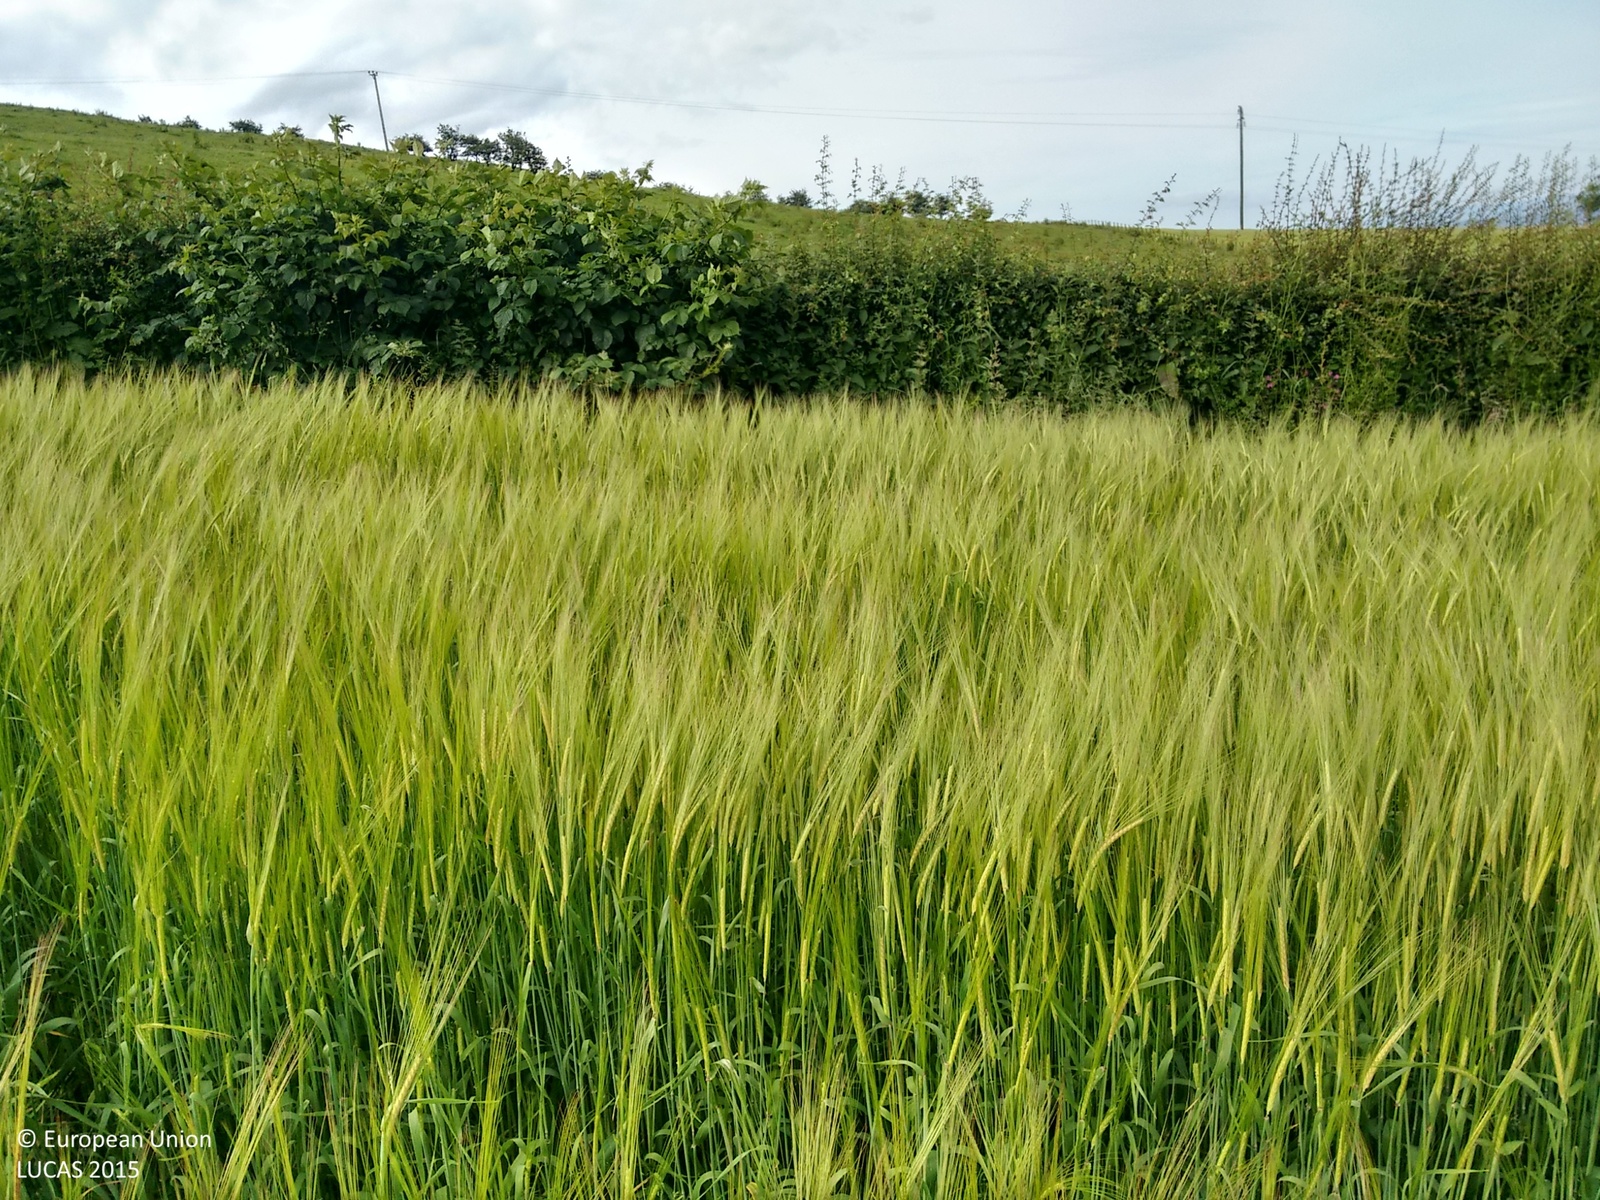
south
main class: Cropland
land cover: Barley
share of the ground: > 75 %
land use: Agriculture (excluding fallow land and kitchen gardens)
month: July
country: GB
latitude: 55.8534
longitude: -5.1130
